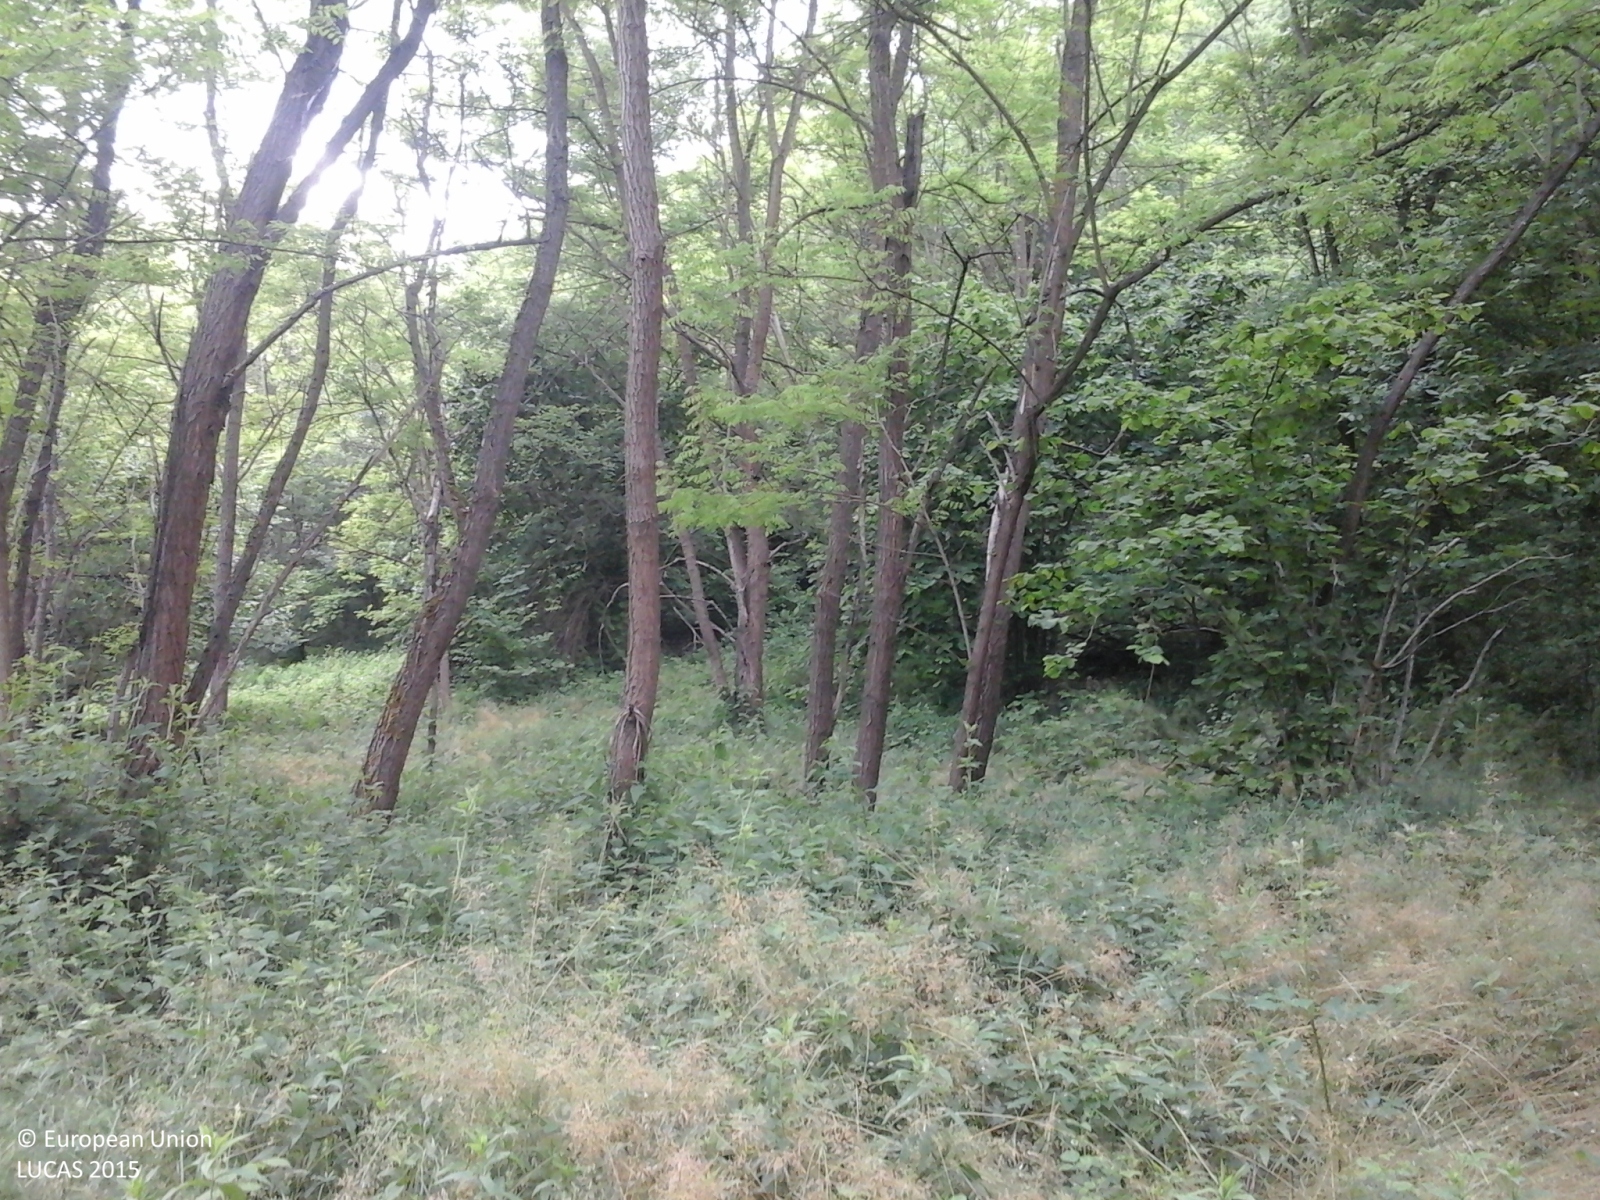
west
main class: Woodland
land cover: Broadleaved woodland
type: thermophilous deciduous forest
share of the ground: > 75 %
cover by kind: broadleaved forest trees 85 %, shrubs 10 %, herbaceous plants 5 %
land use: Forestry
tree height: > 5 m
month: May
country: IT
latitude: 44.8420
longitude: 8.3207
